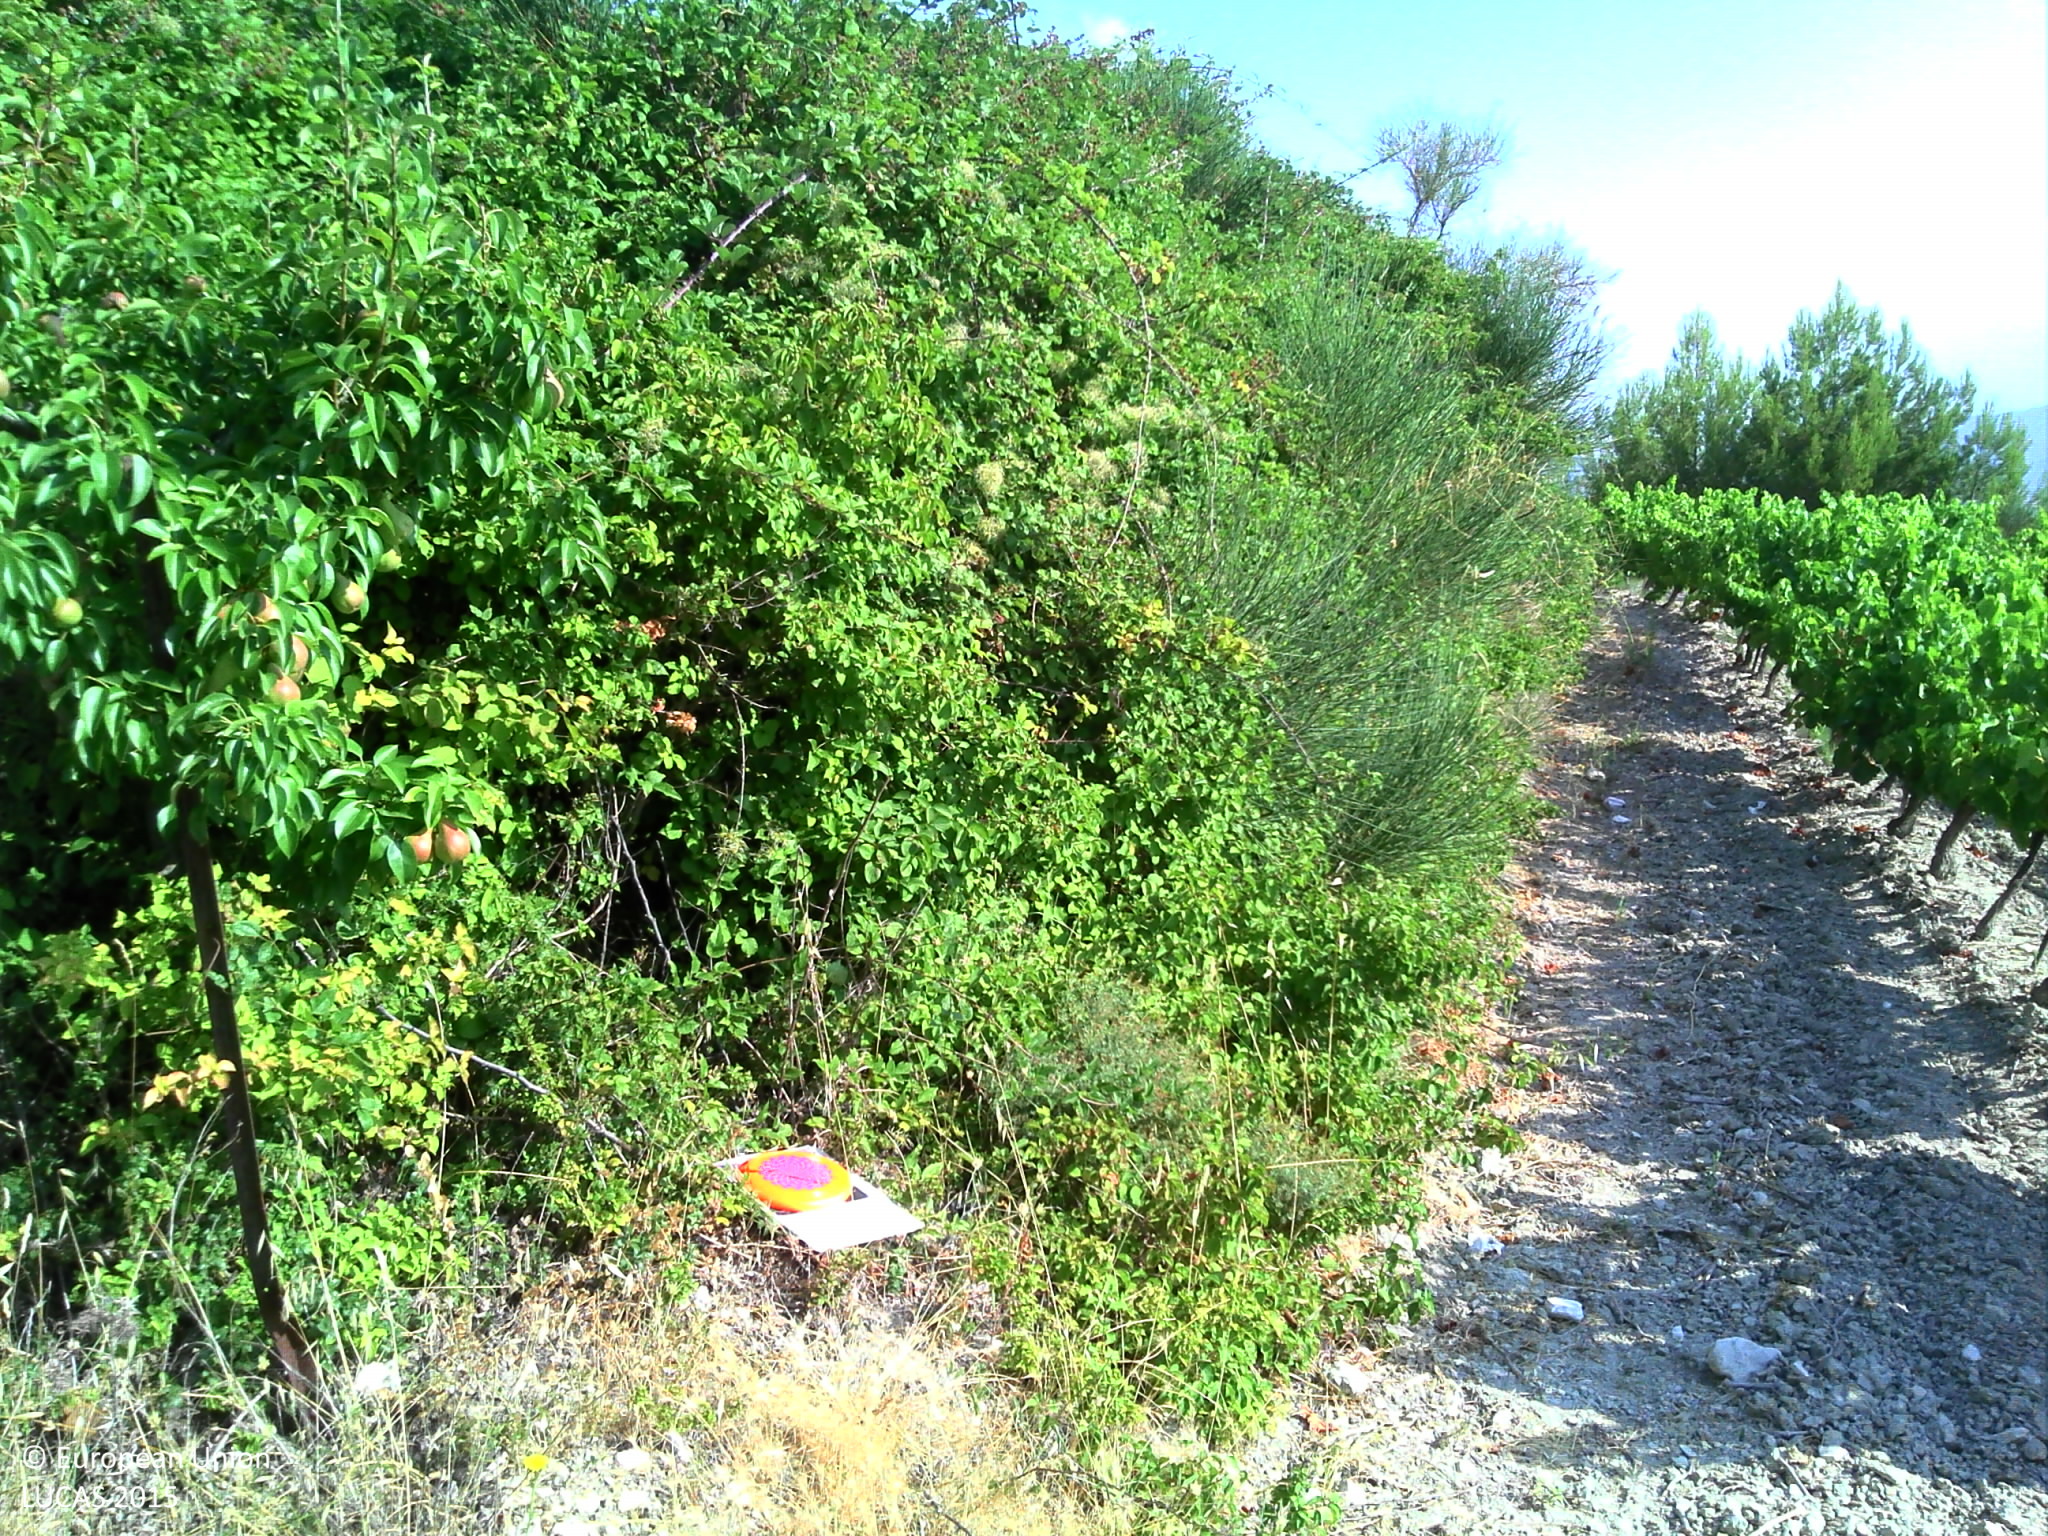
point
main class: Shrubland
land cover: Shrubland without tree cover
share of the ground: > 75 %
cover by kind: shrubs 70 %, herbaceous plants 20 %, unconsolidated bare surface 10 %
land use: Semi-natural and natural areas not in use
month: July
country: FR
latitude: 44.0758
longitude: 5.1758
